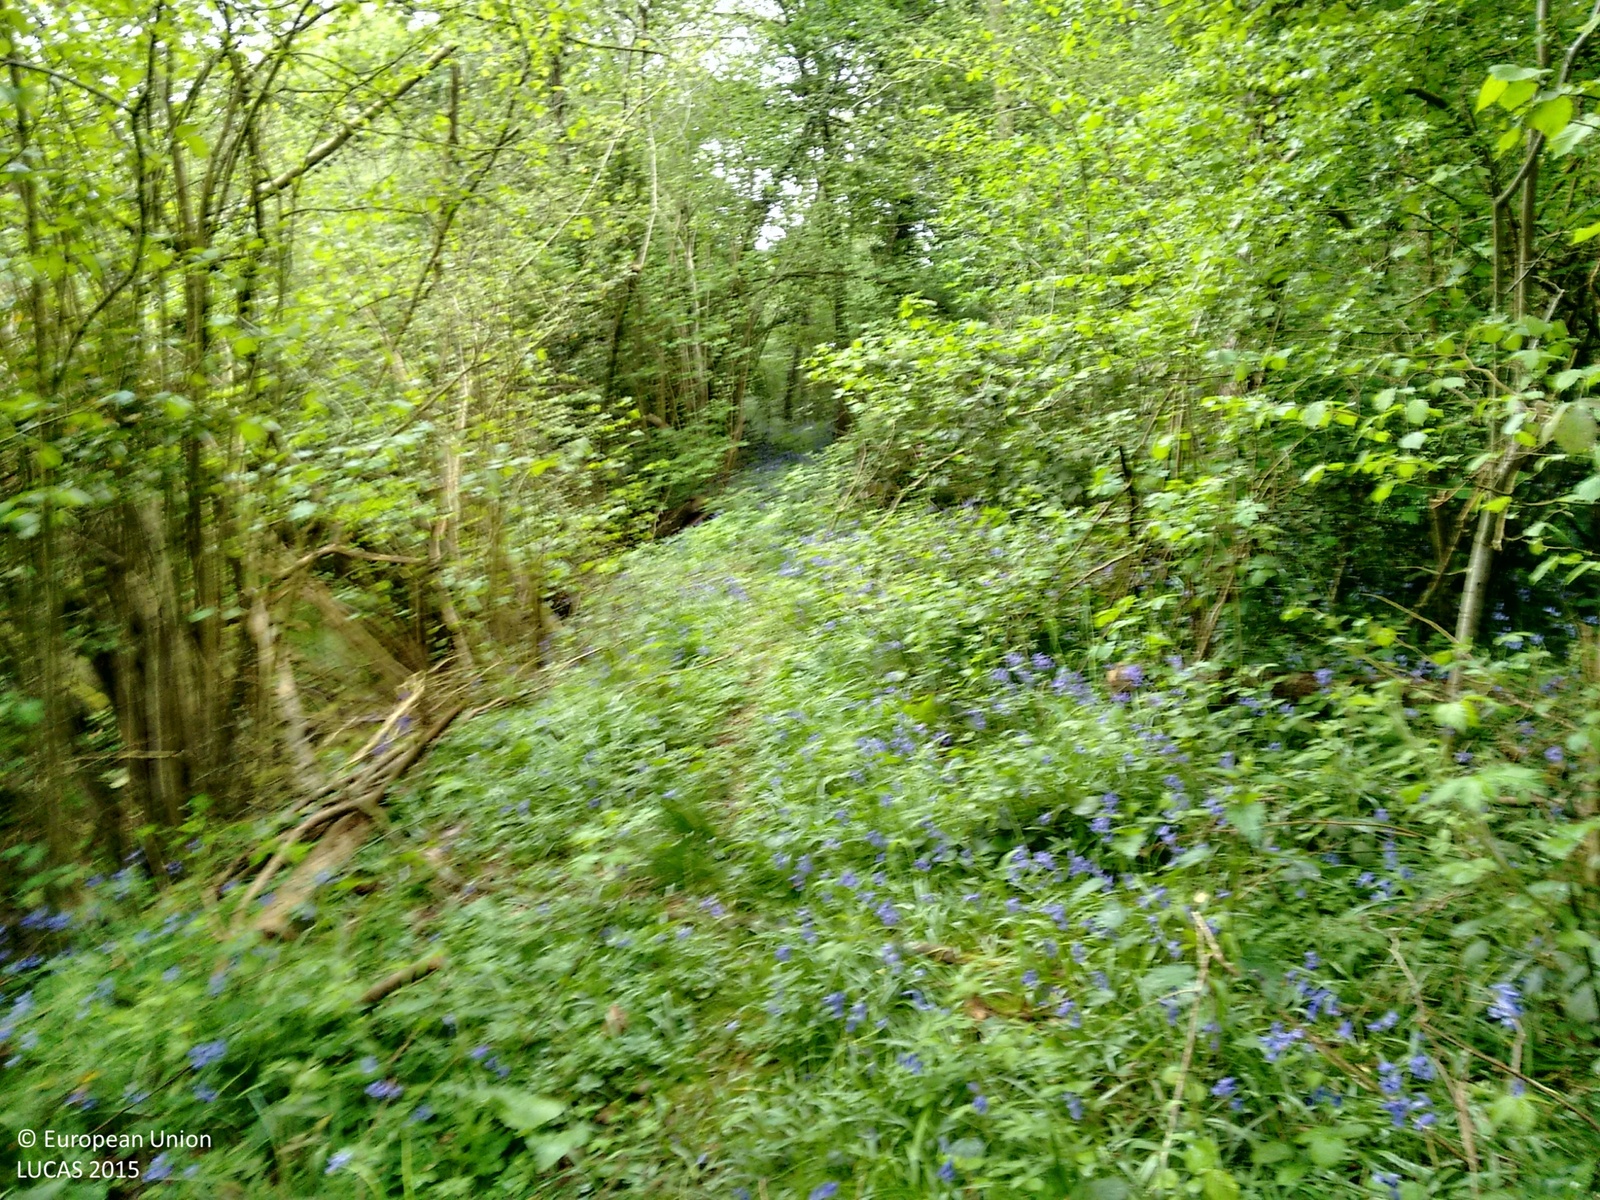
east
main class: Woodland
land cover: Broadleaved woodland
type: mesophytic deciduous forest
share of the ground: > 75 %
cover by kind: broadleaved forest trees 85 %, herbaceous plants 10 %, shrubs 5 %
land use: Semi-natural and natural areas not in use
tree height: > 5 m
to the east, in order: Broadleaved woodland; Rivers and streams; Grassland without tree/shrub cover; Common wheat; Grass margins; Abandoned hedges; Rivers and streams; Abandoned hedges; Grassland without tree/shrub cover
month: May
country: GB
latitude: 52.2924
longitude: -2.1865
